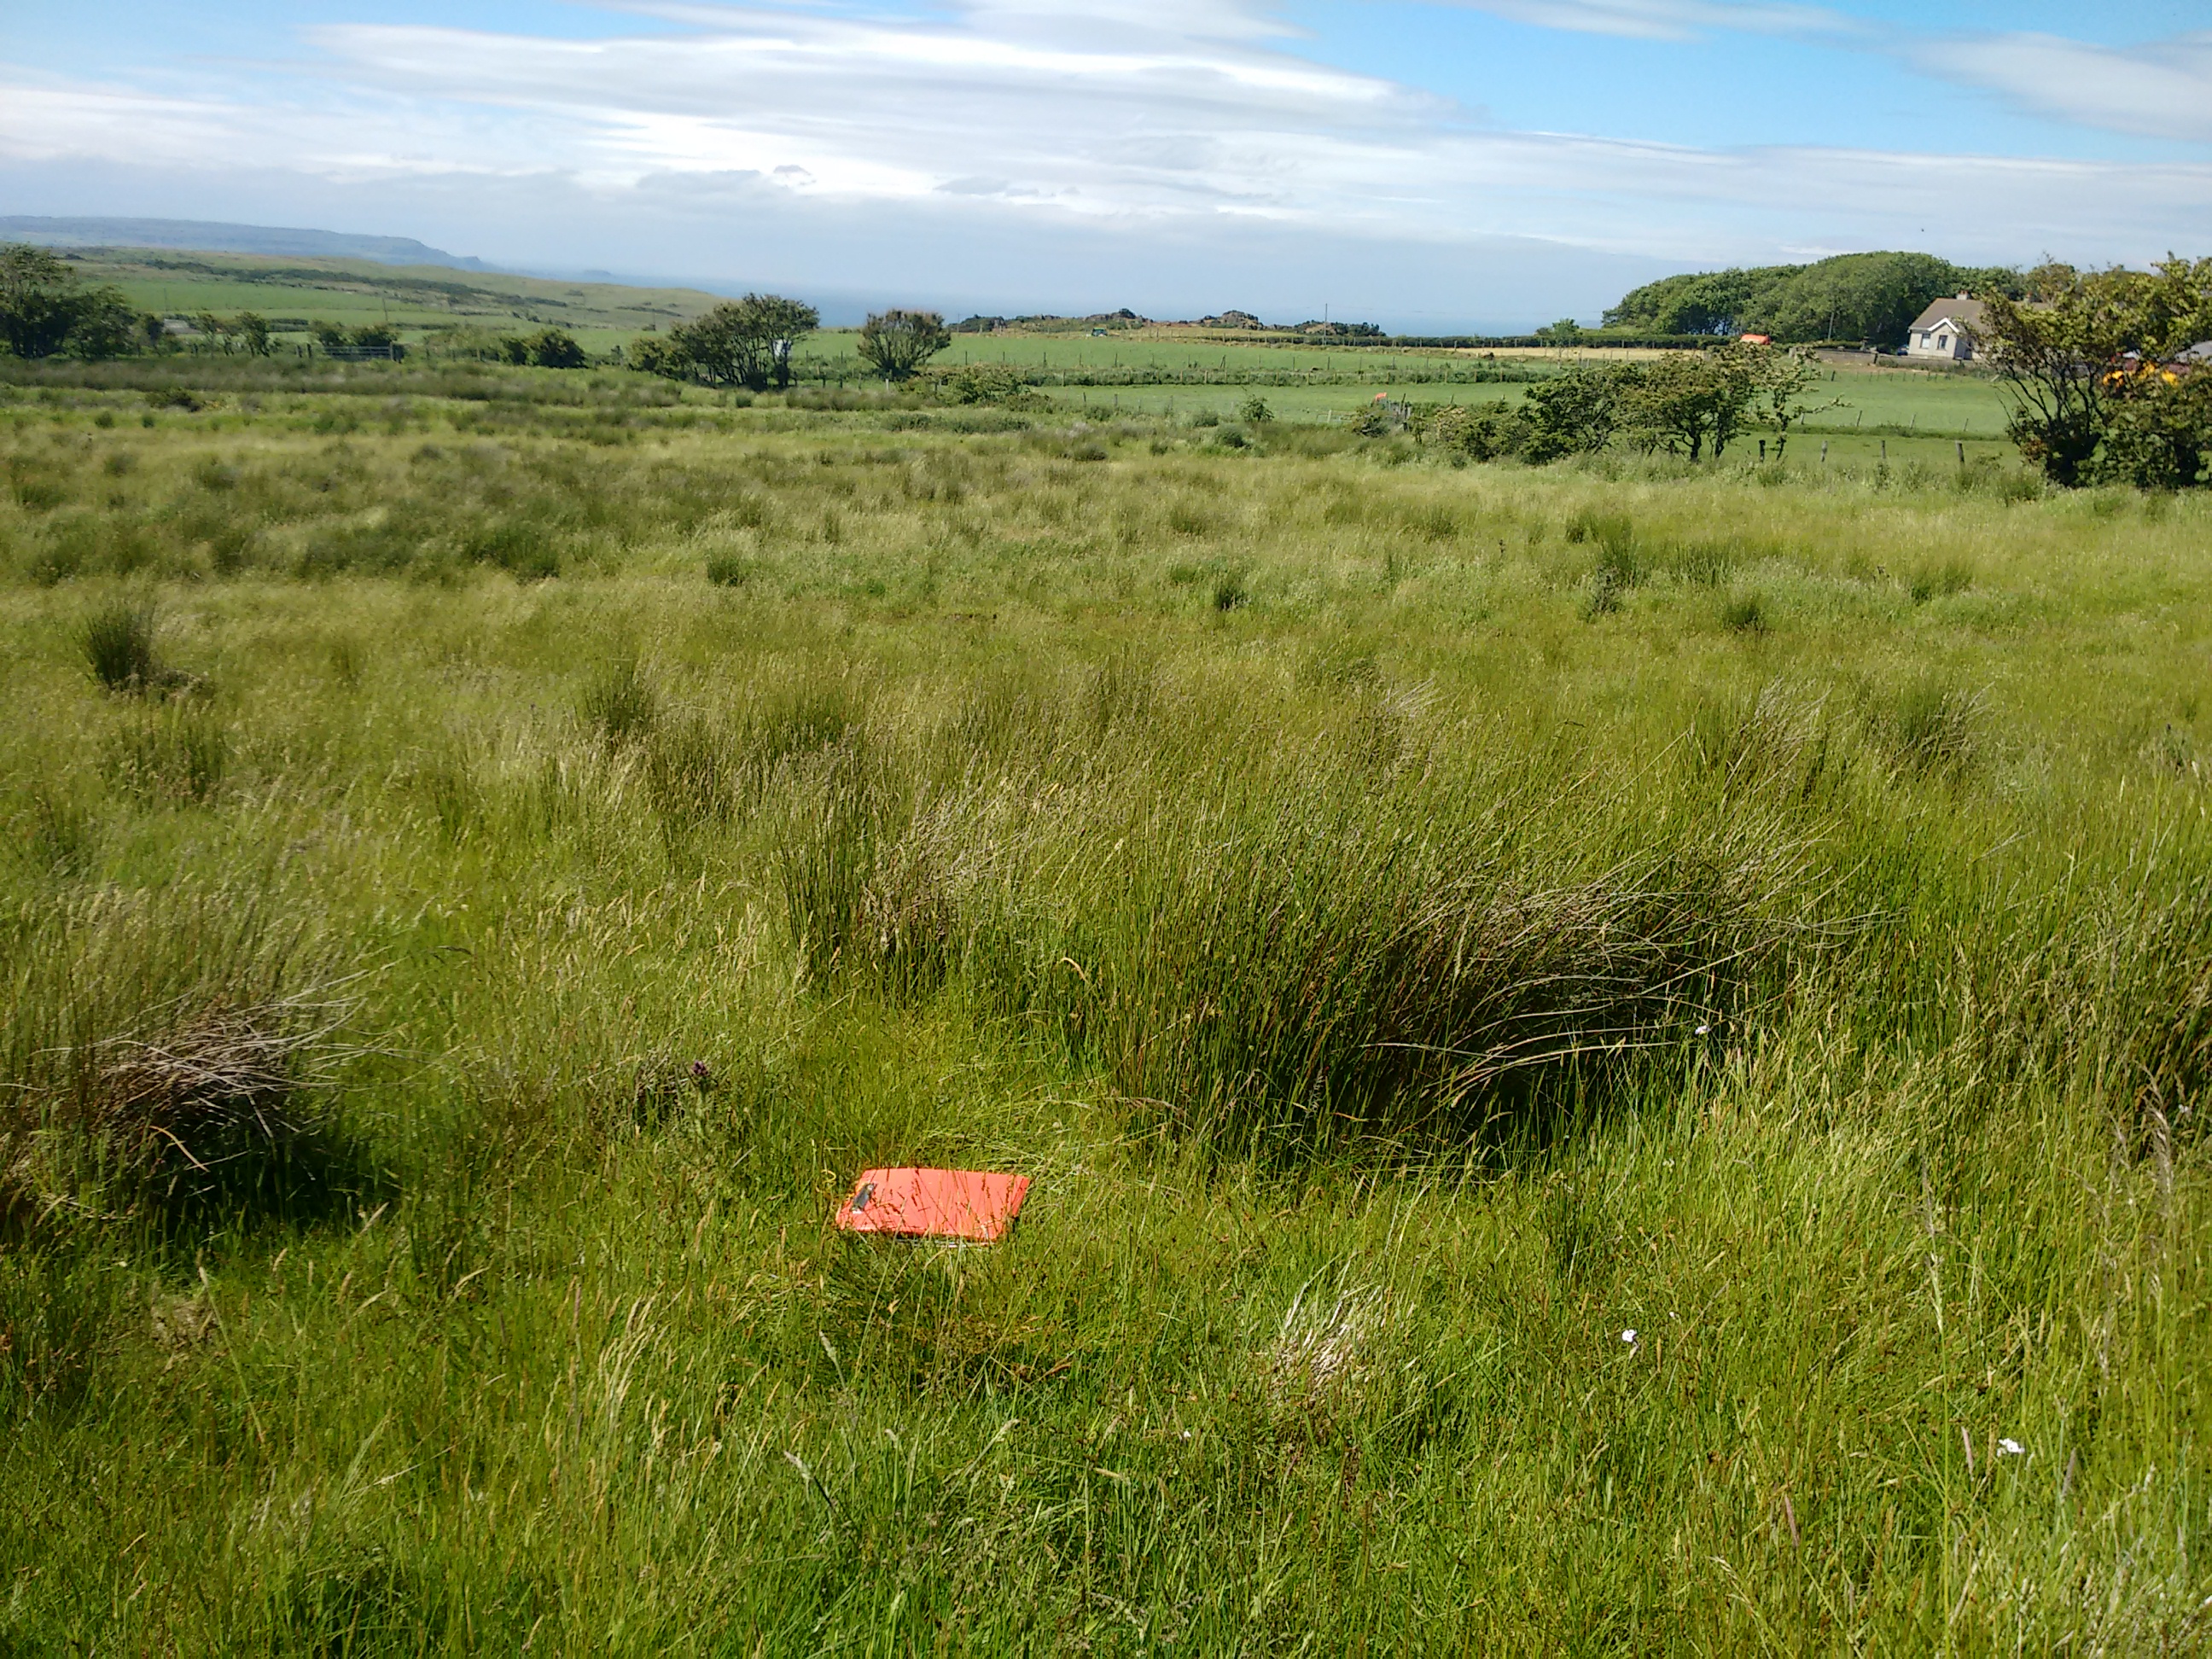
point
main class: Grassland
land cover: Grassland without tree/shrub cover
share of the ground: > 75 %
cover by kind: herbaceous plants 100 %
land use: Agriculture (excluding fallow land and kitchen gardens)
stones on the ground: < 10 %
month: June
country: GB
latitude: 55.2087
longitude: -6.1566
